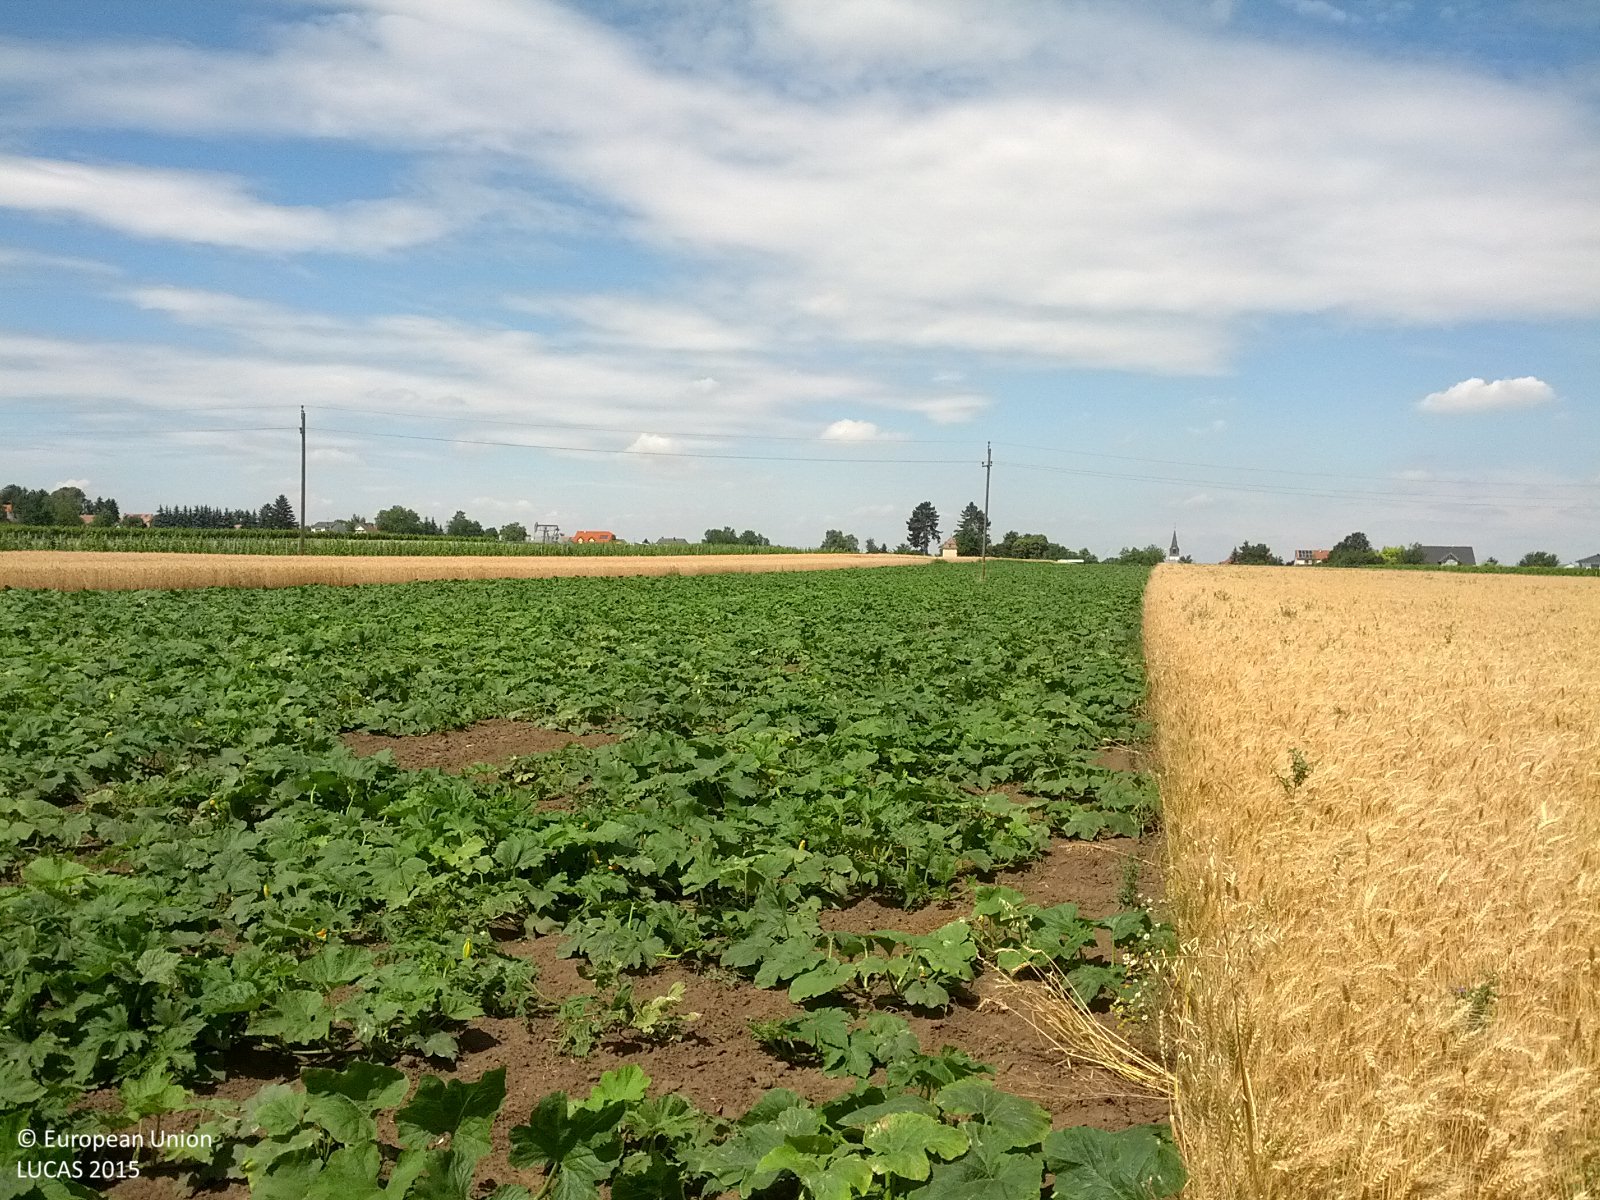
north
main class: Cropland
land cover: Other fresh vegetables
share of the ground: > 75 %
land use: Agriculture (excluding fallow land and kitchen gardens)
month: June
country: AT
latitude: 48.3667
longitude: 16.6340
